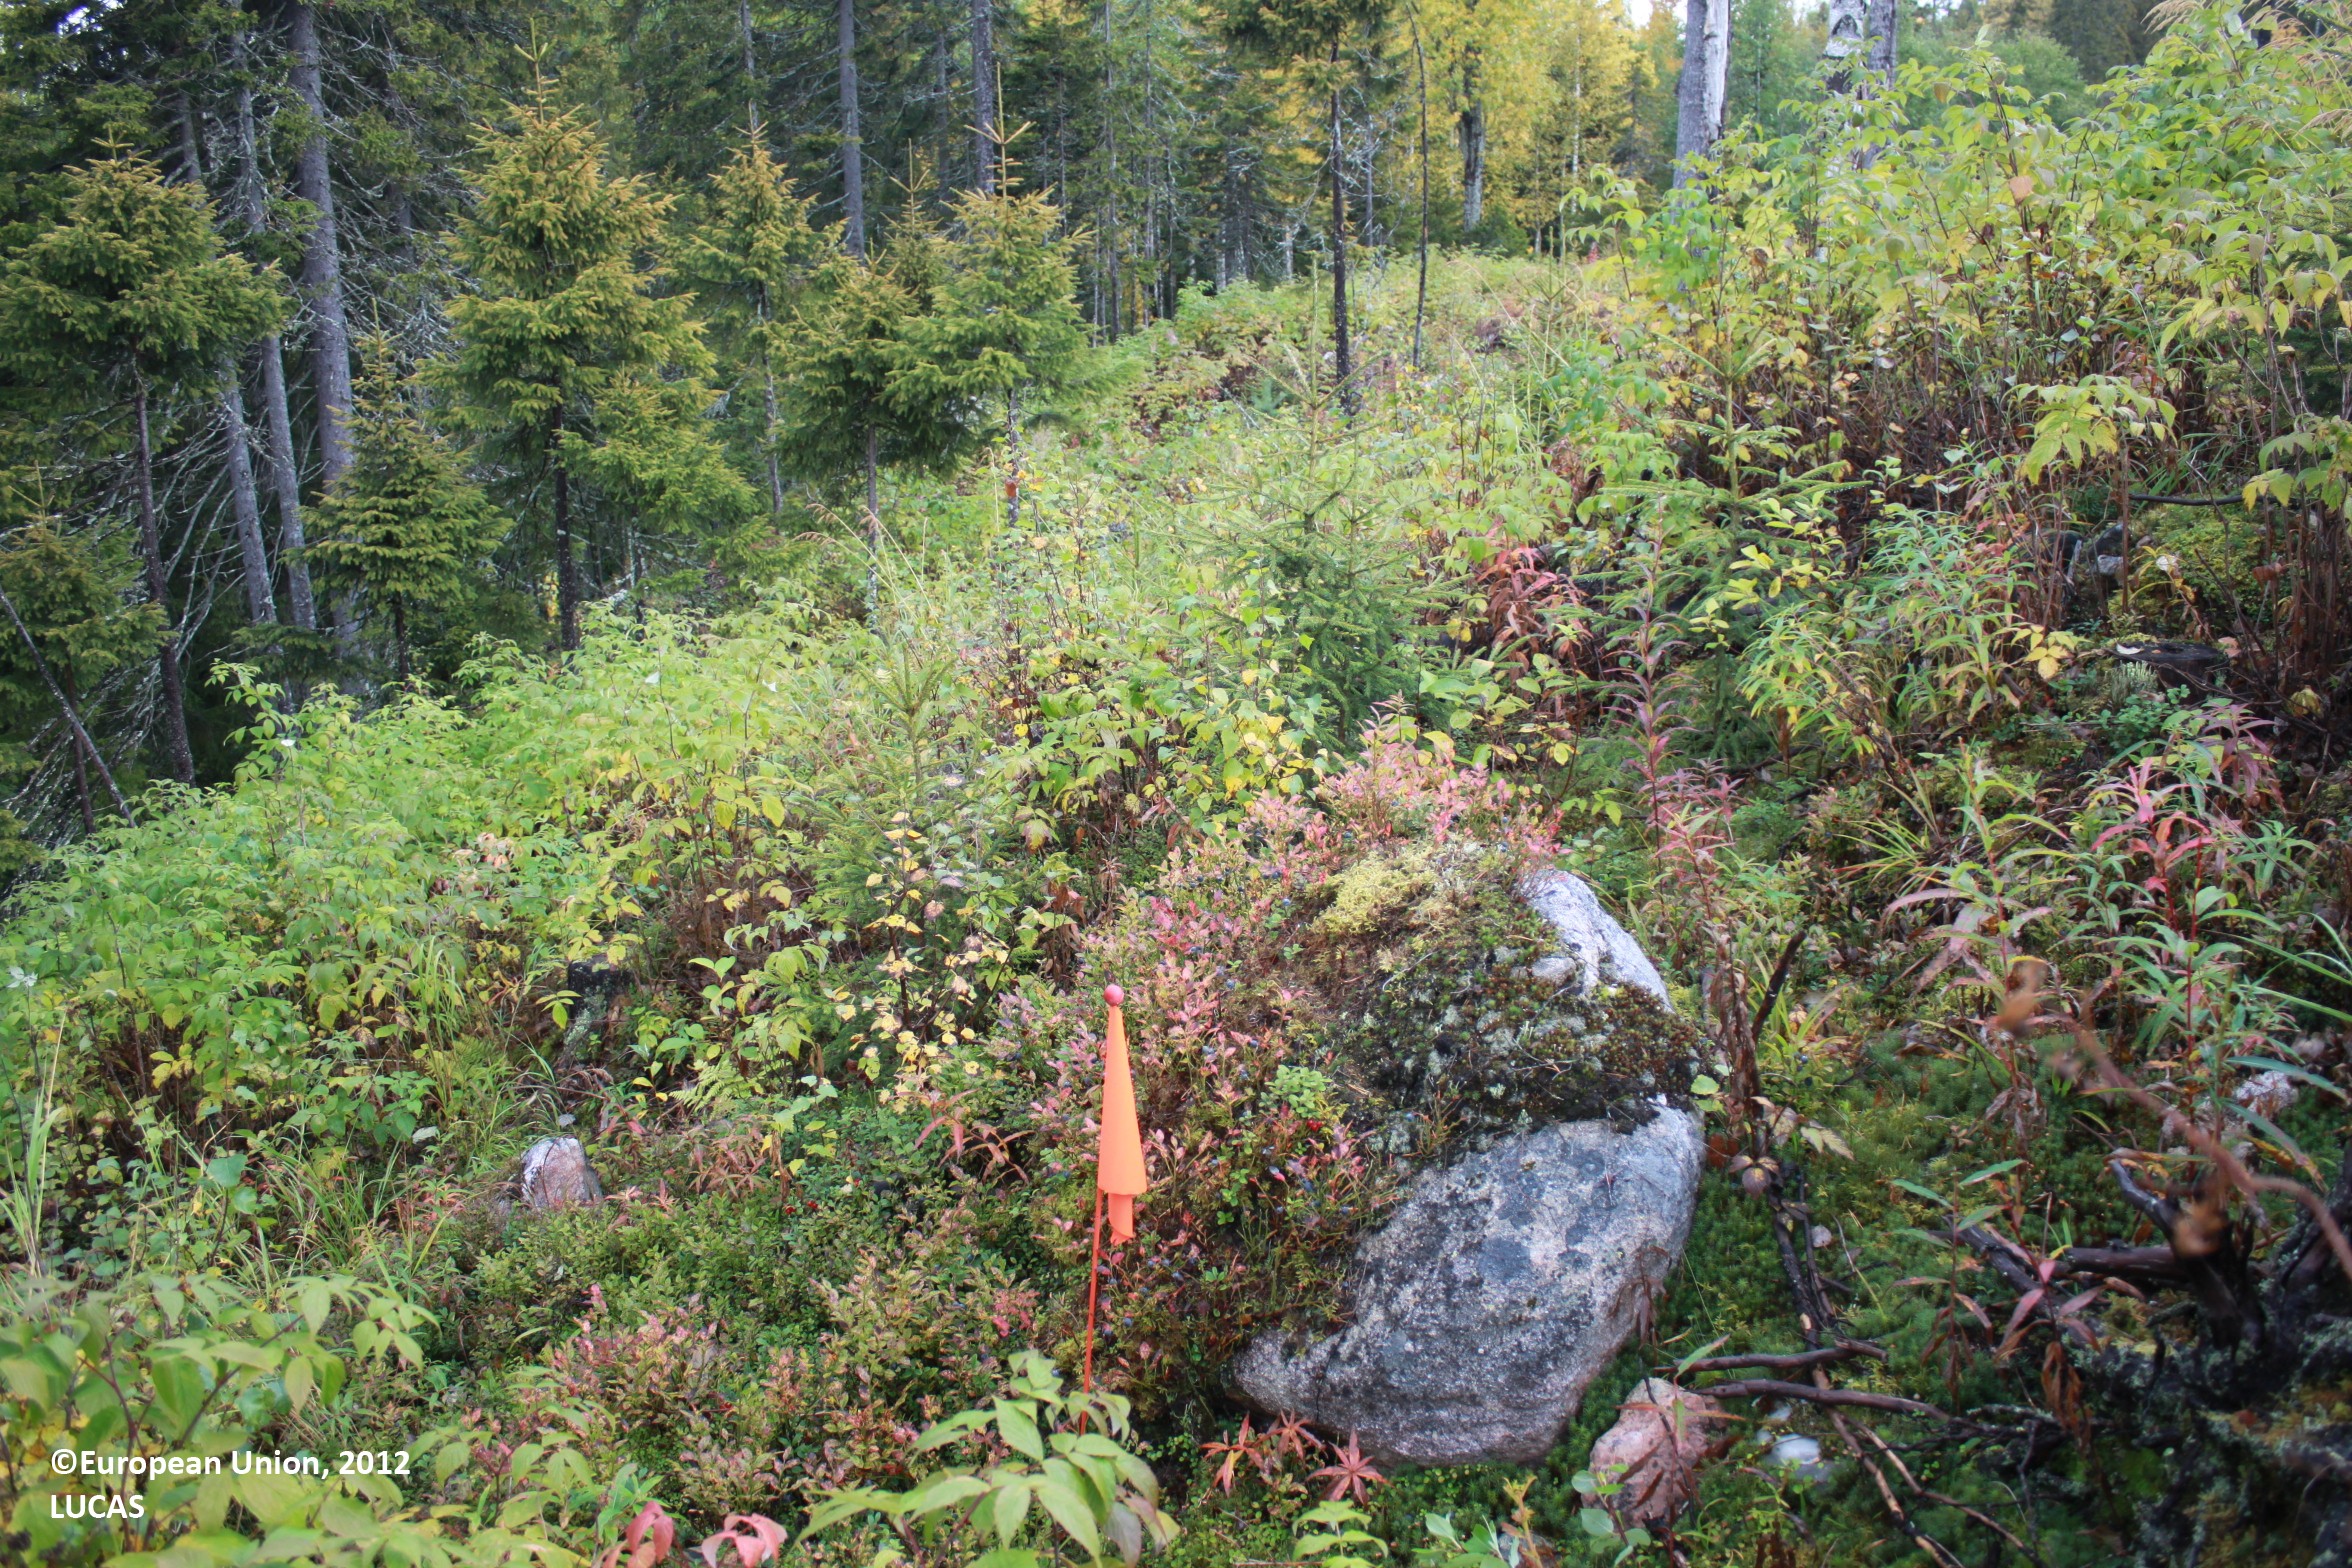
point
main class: Shrubland
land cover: Shrubland with sparse tree cover
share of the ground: > 75 %
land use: Forestry
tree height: < 5 m
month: September
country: FI
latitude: 65.6928
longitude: 27.4331
